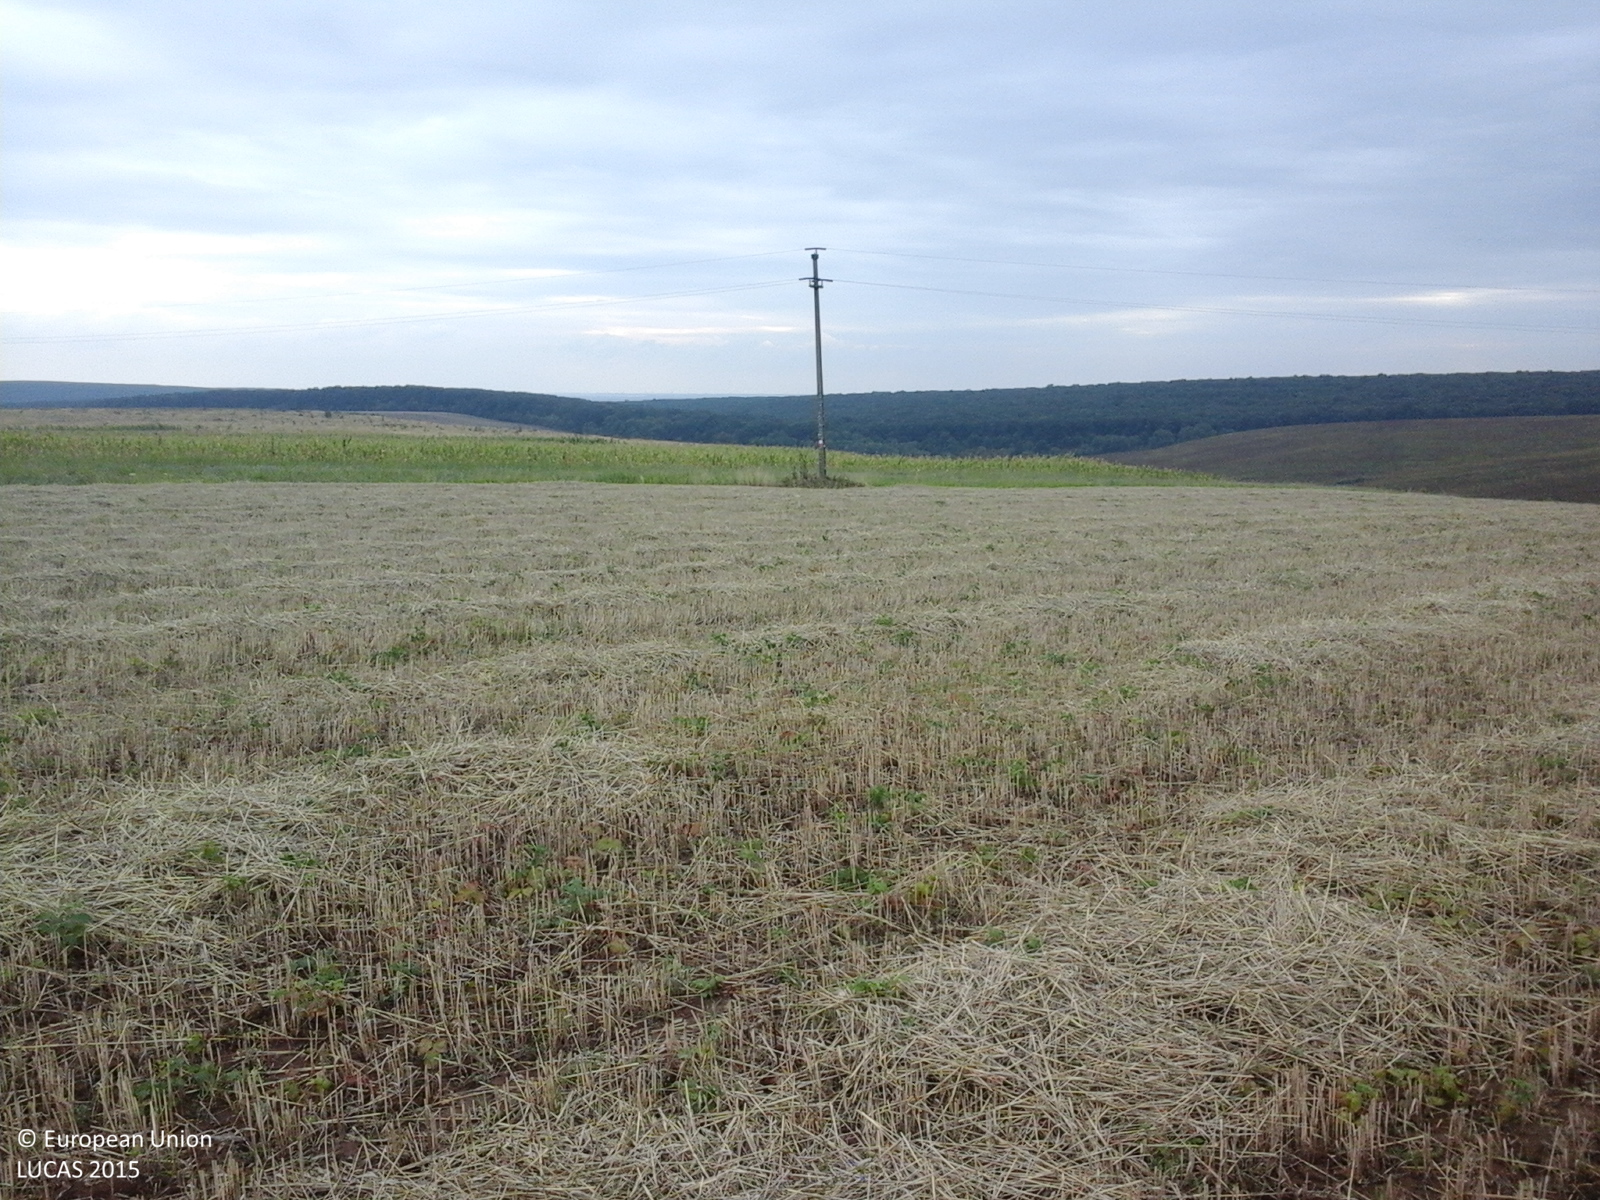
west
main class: Cropland
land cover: Durum wheat
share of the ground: > 75 %
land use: Agriculture (excluding fallow land and kitchen gardens)
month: August
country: RO
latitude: 45.8728
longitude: 21.5133
